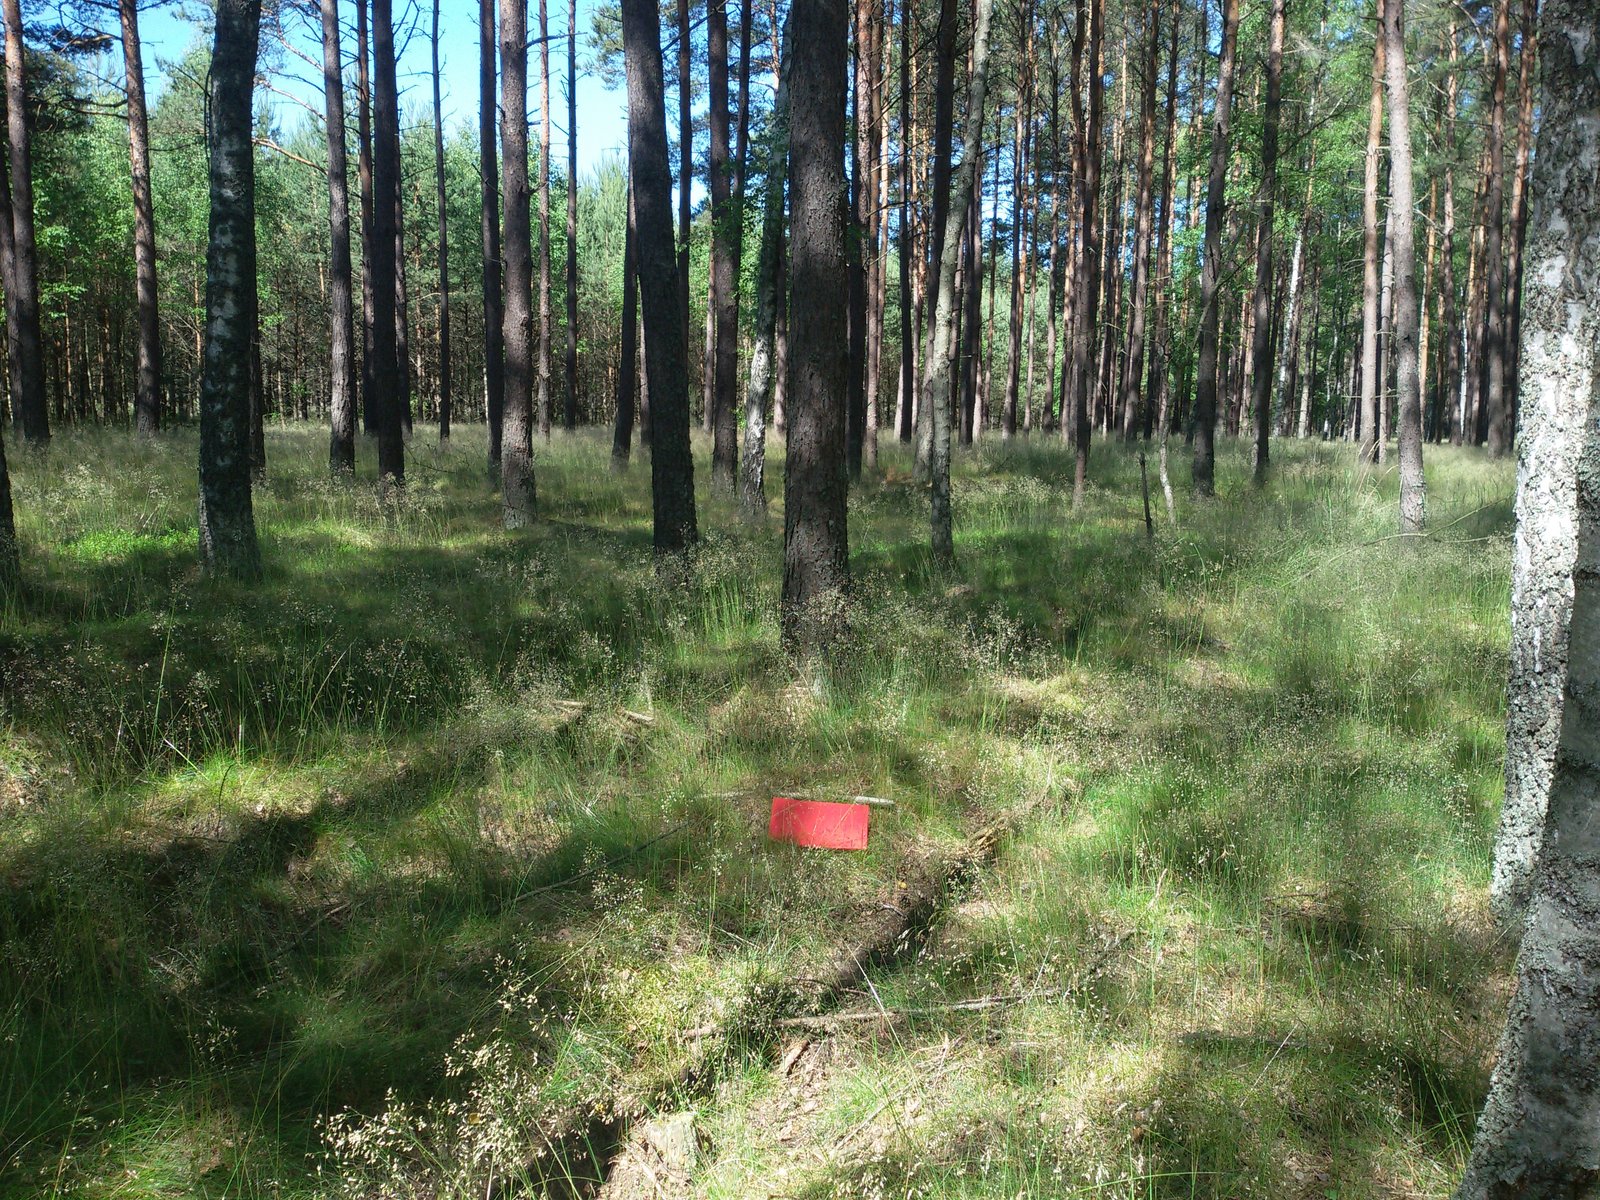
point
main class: Woodland
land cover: Pine dominated mixed woodland
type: hemiboreal forest and nemoral coniferous forest and mixed broadleaved-coniferous forest
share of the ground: > 75 %
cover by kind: coniferous forest trees 60 %, broadleaved forest trees 30 %, herbaceous plants 10 %
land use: Forestry
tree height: > 5 m
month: July
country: PL
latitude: 53.4714
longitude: 16.3185
